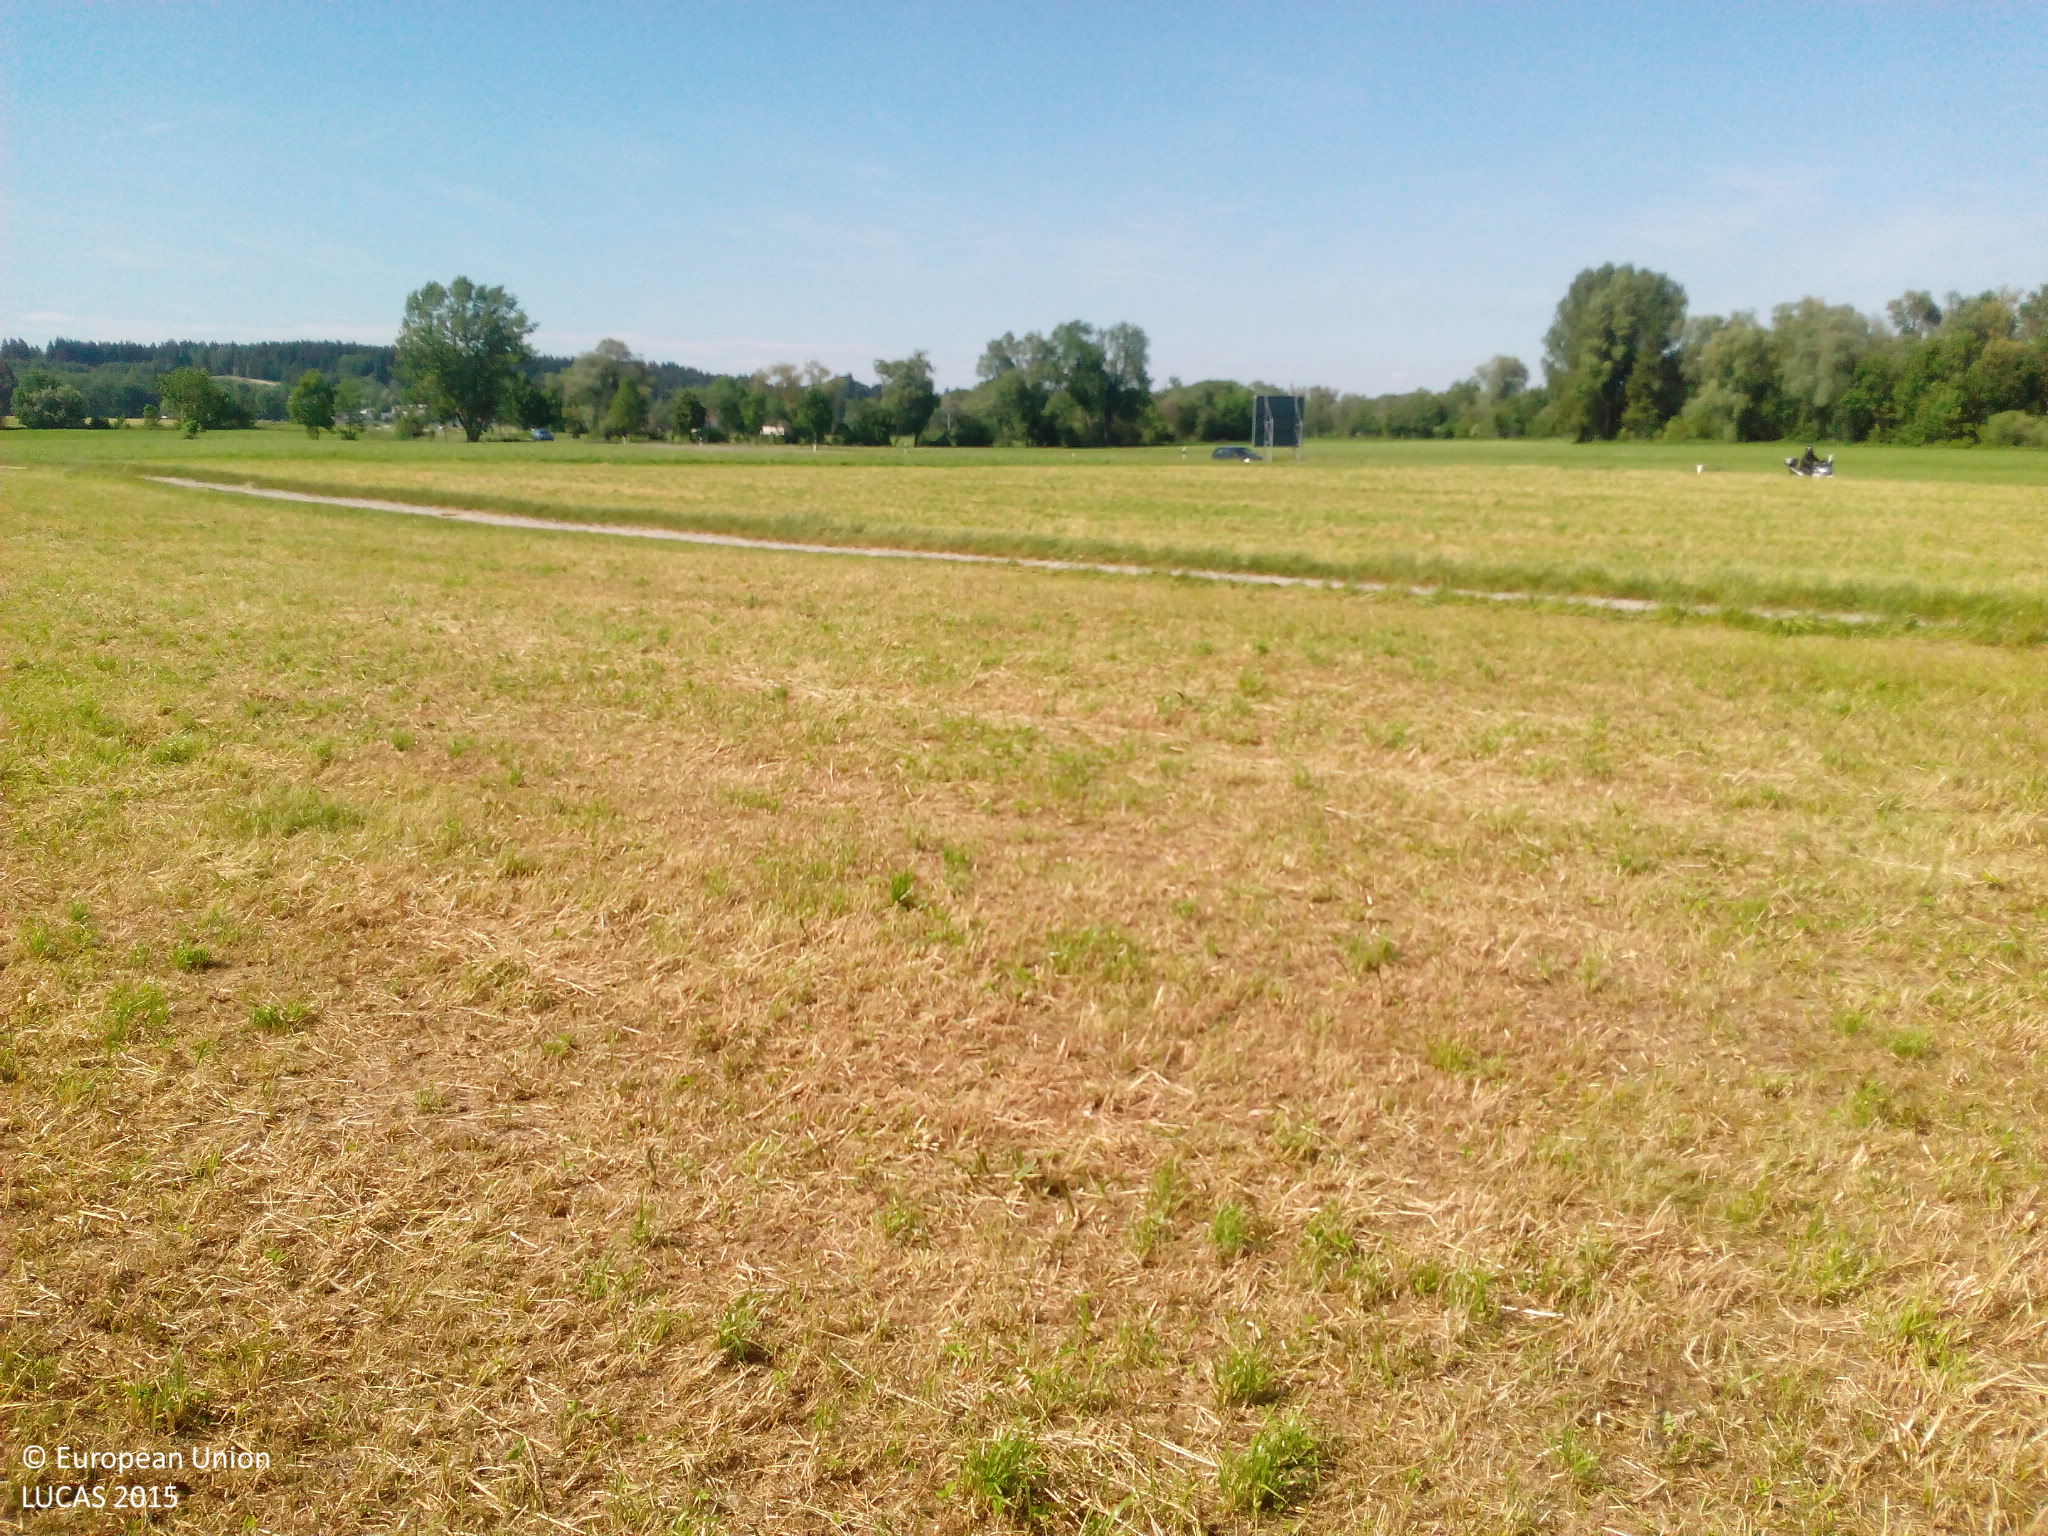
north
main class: Grassland
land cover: Grassland without tree/shrub cover
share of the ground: > 75 %
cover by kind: herbaceous plants 100 %
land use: Agriculture (excluding fallow land and kitchen gardens)
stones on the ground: < 10 %
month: June
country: DE
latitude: 47.9160
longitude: 10.6017
